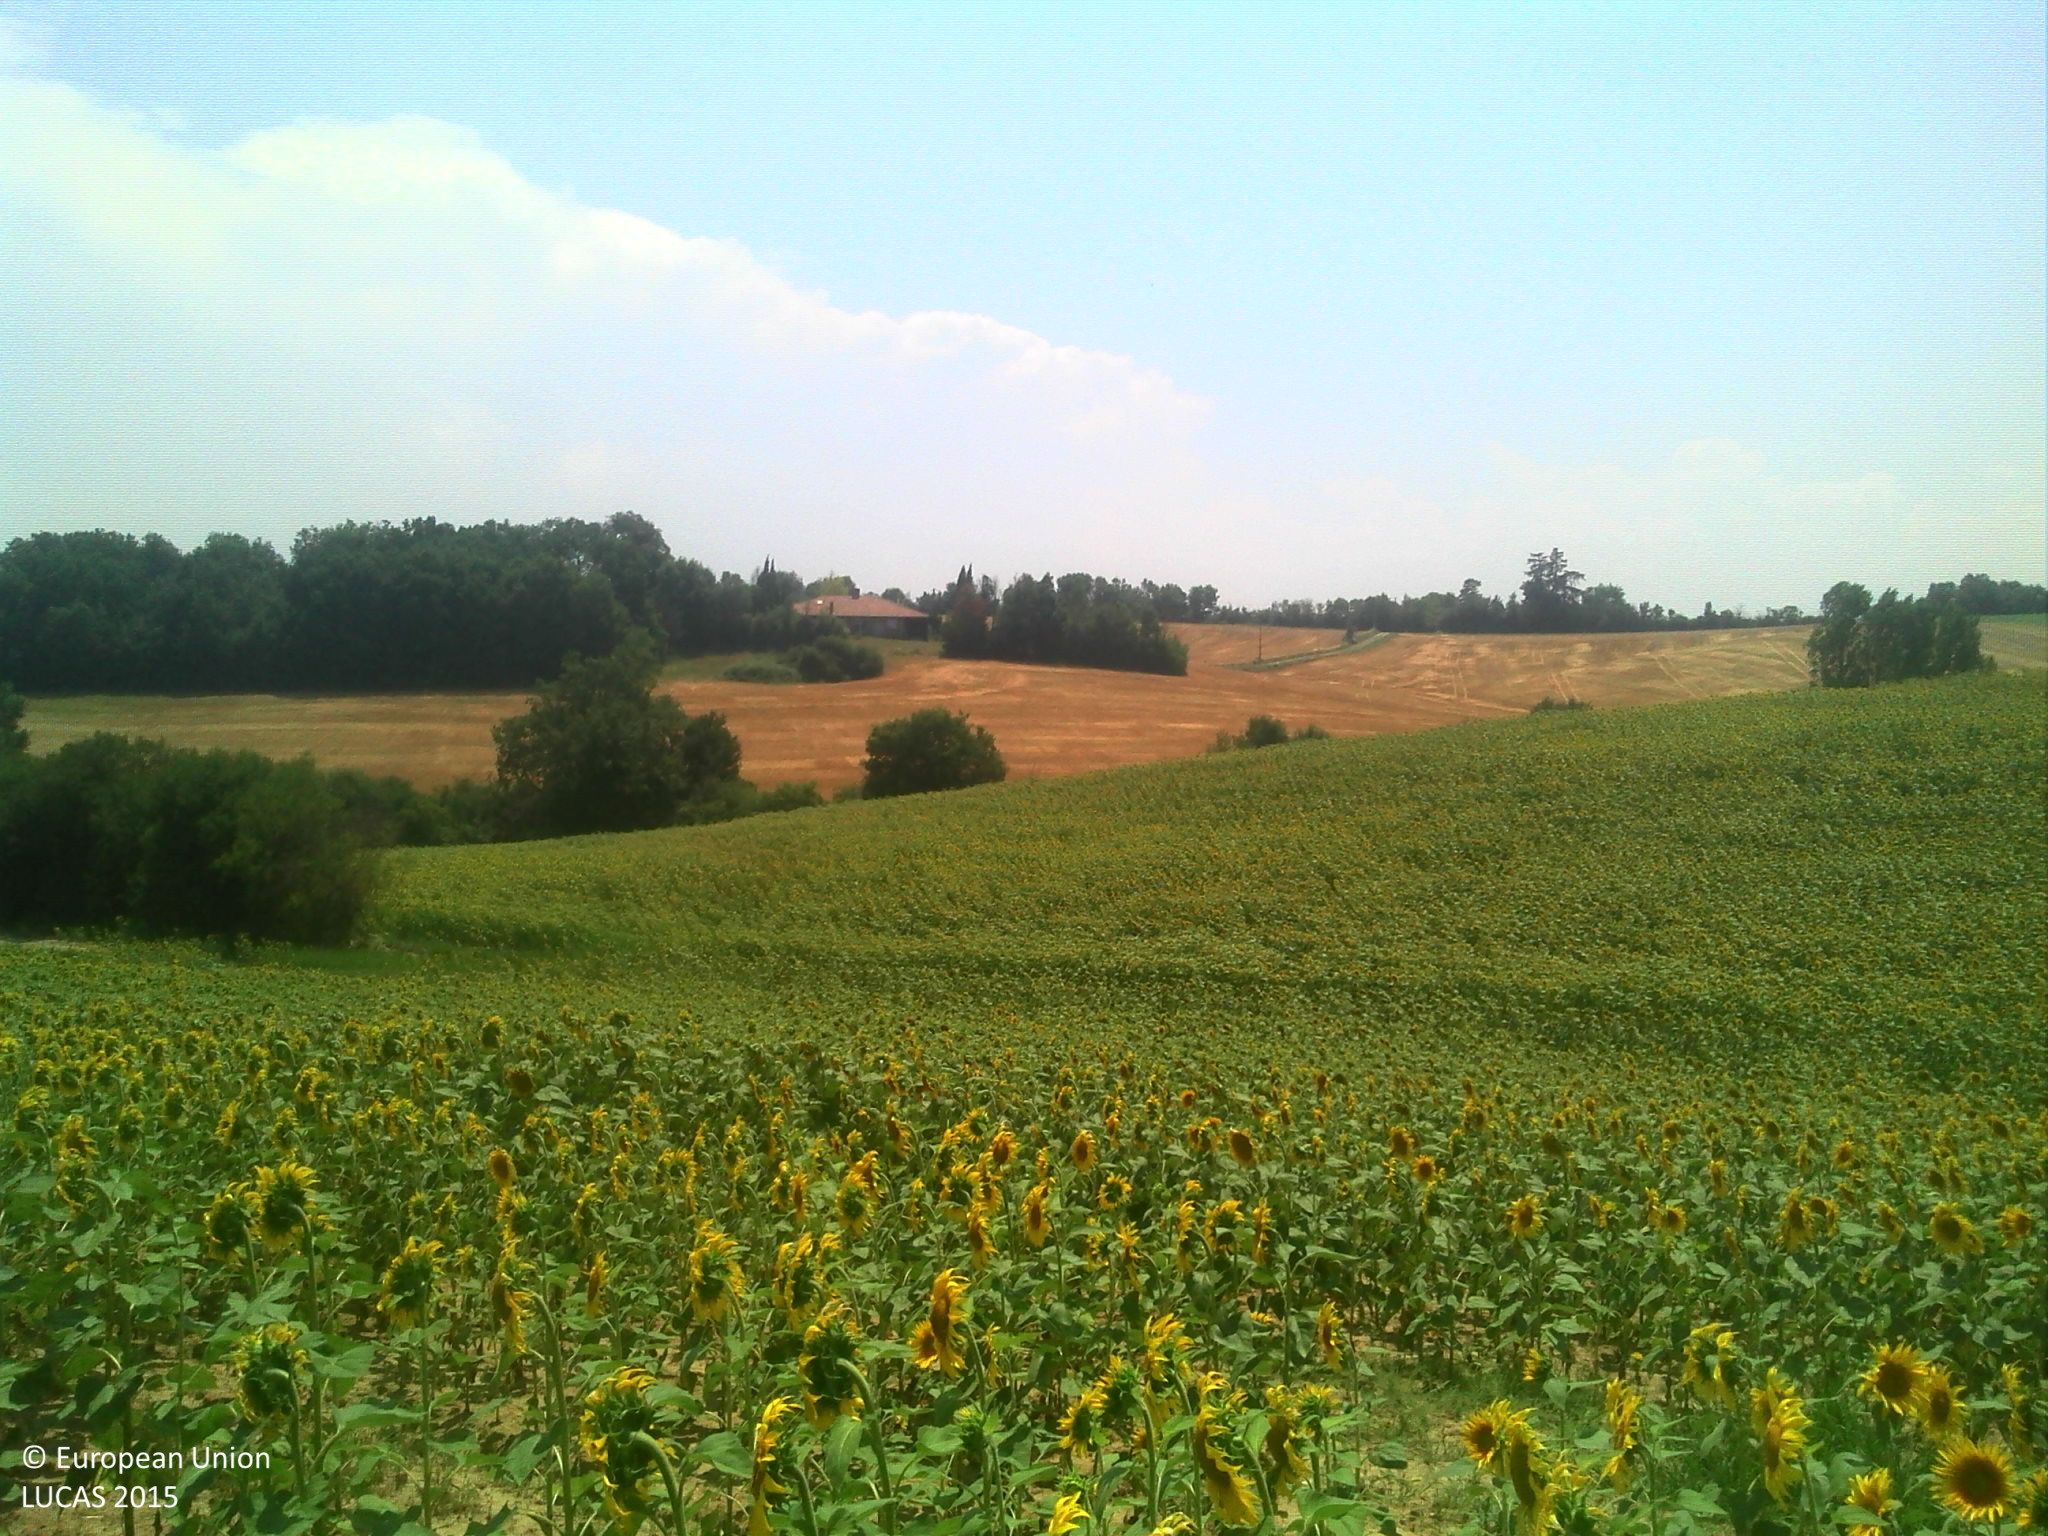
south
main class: Grassland
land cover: Grassland without tree/shrub cover
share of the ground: > 75 %
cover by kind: herbaceous plants 100 %
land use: Agriculture (excluding fallow land and kitchen gardens)
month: July
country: FR
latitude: 43.3807
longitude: 1.0283
